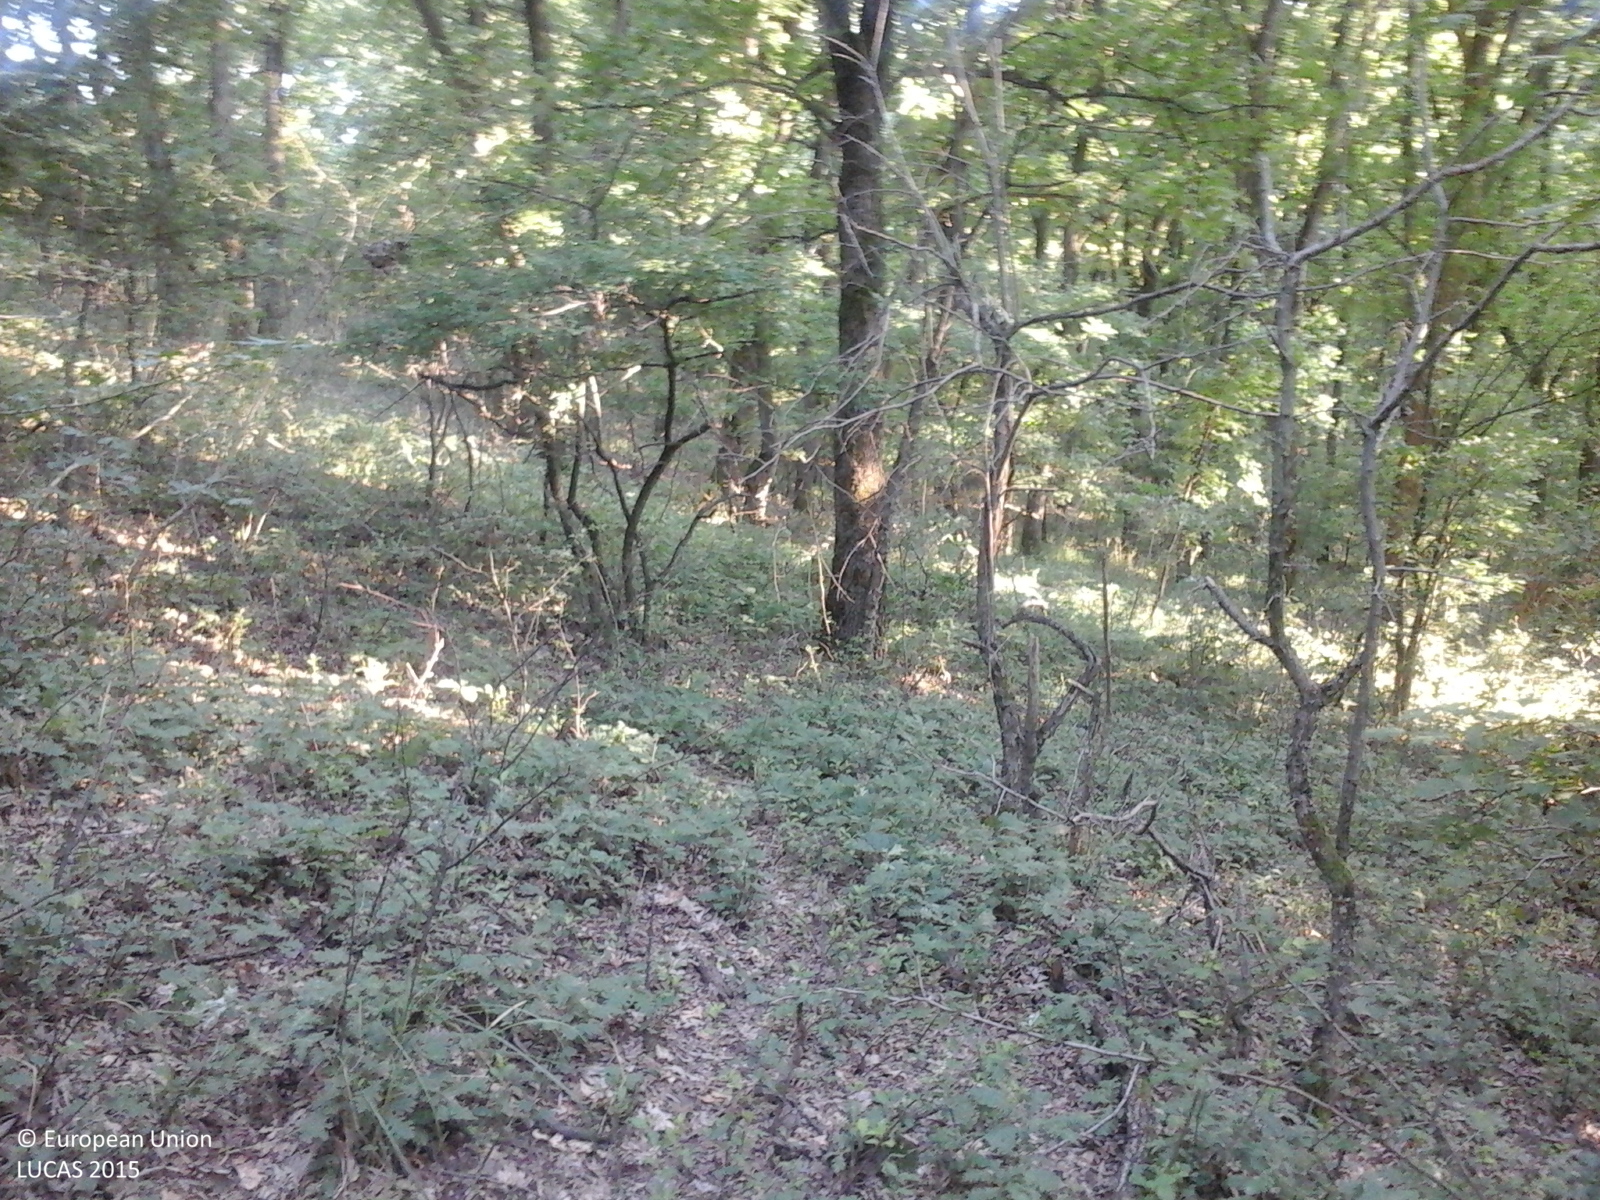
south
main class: Woodland
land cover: Broadleaved woodland
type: acidophilous oak and oak-birch forest
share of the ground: > 75 %
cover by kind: broadleaved forest trees 95 %, herbaceous plants 5 %
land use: Forestry
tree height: > 5 m
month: July
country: RO
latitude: 44.5646
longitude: 24.5393
